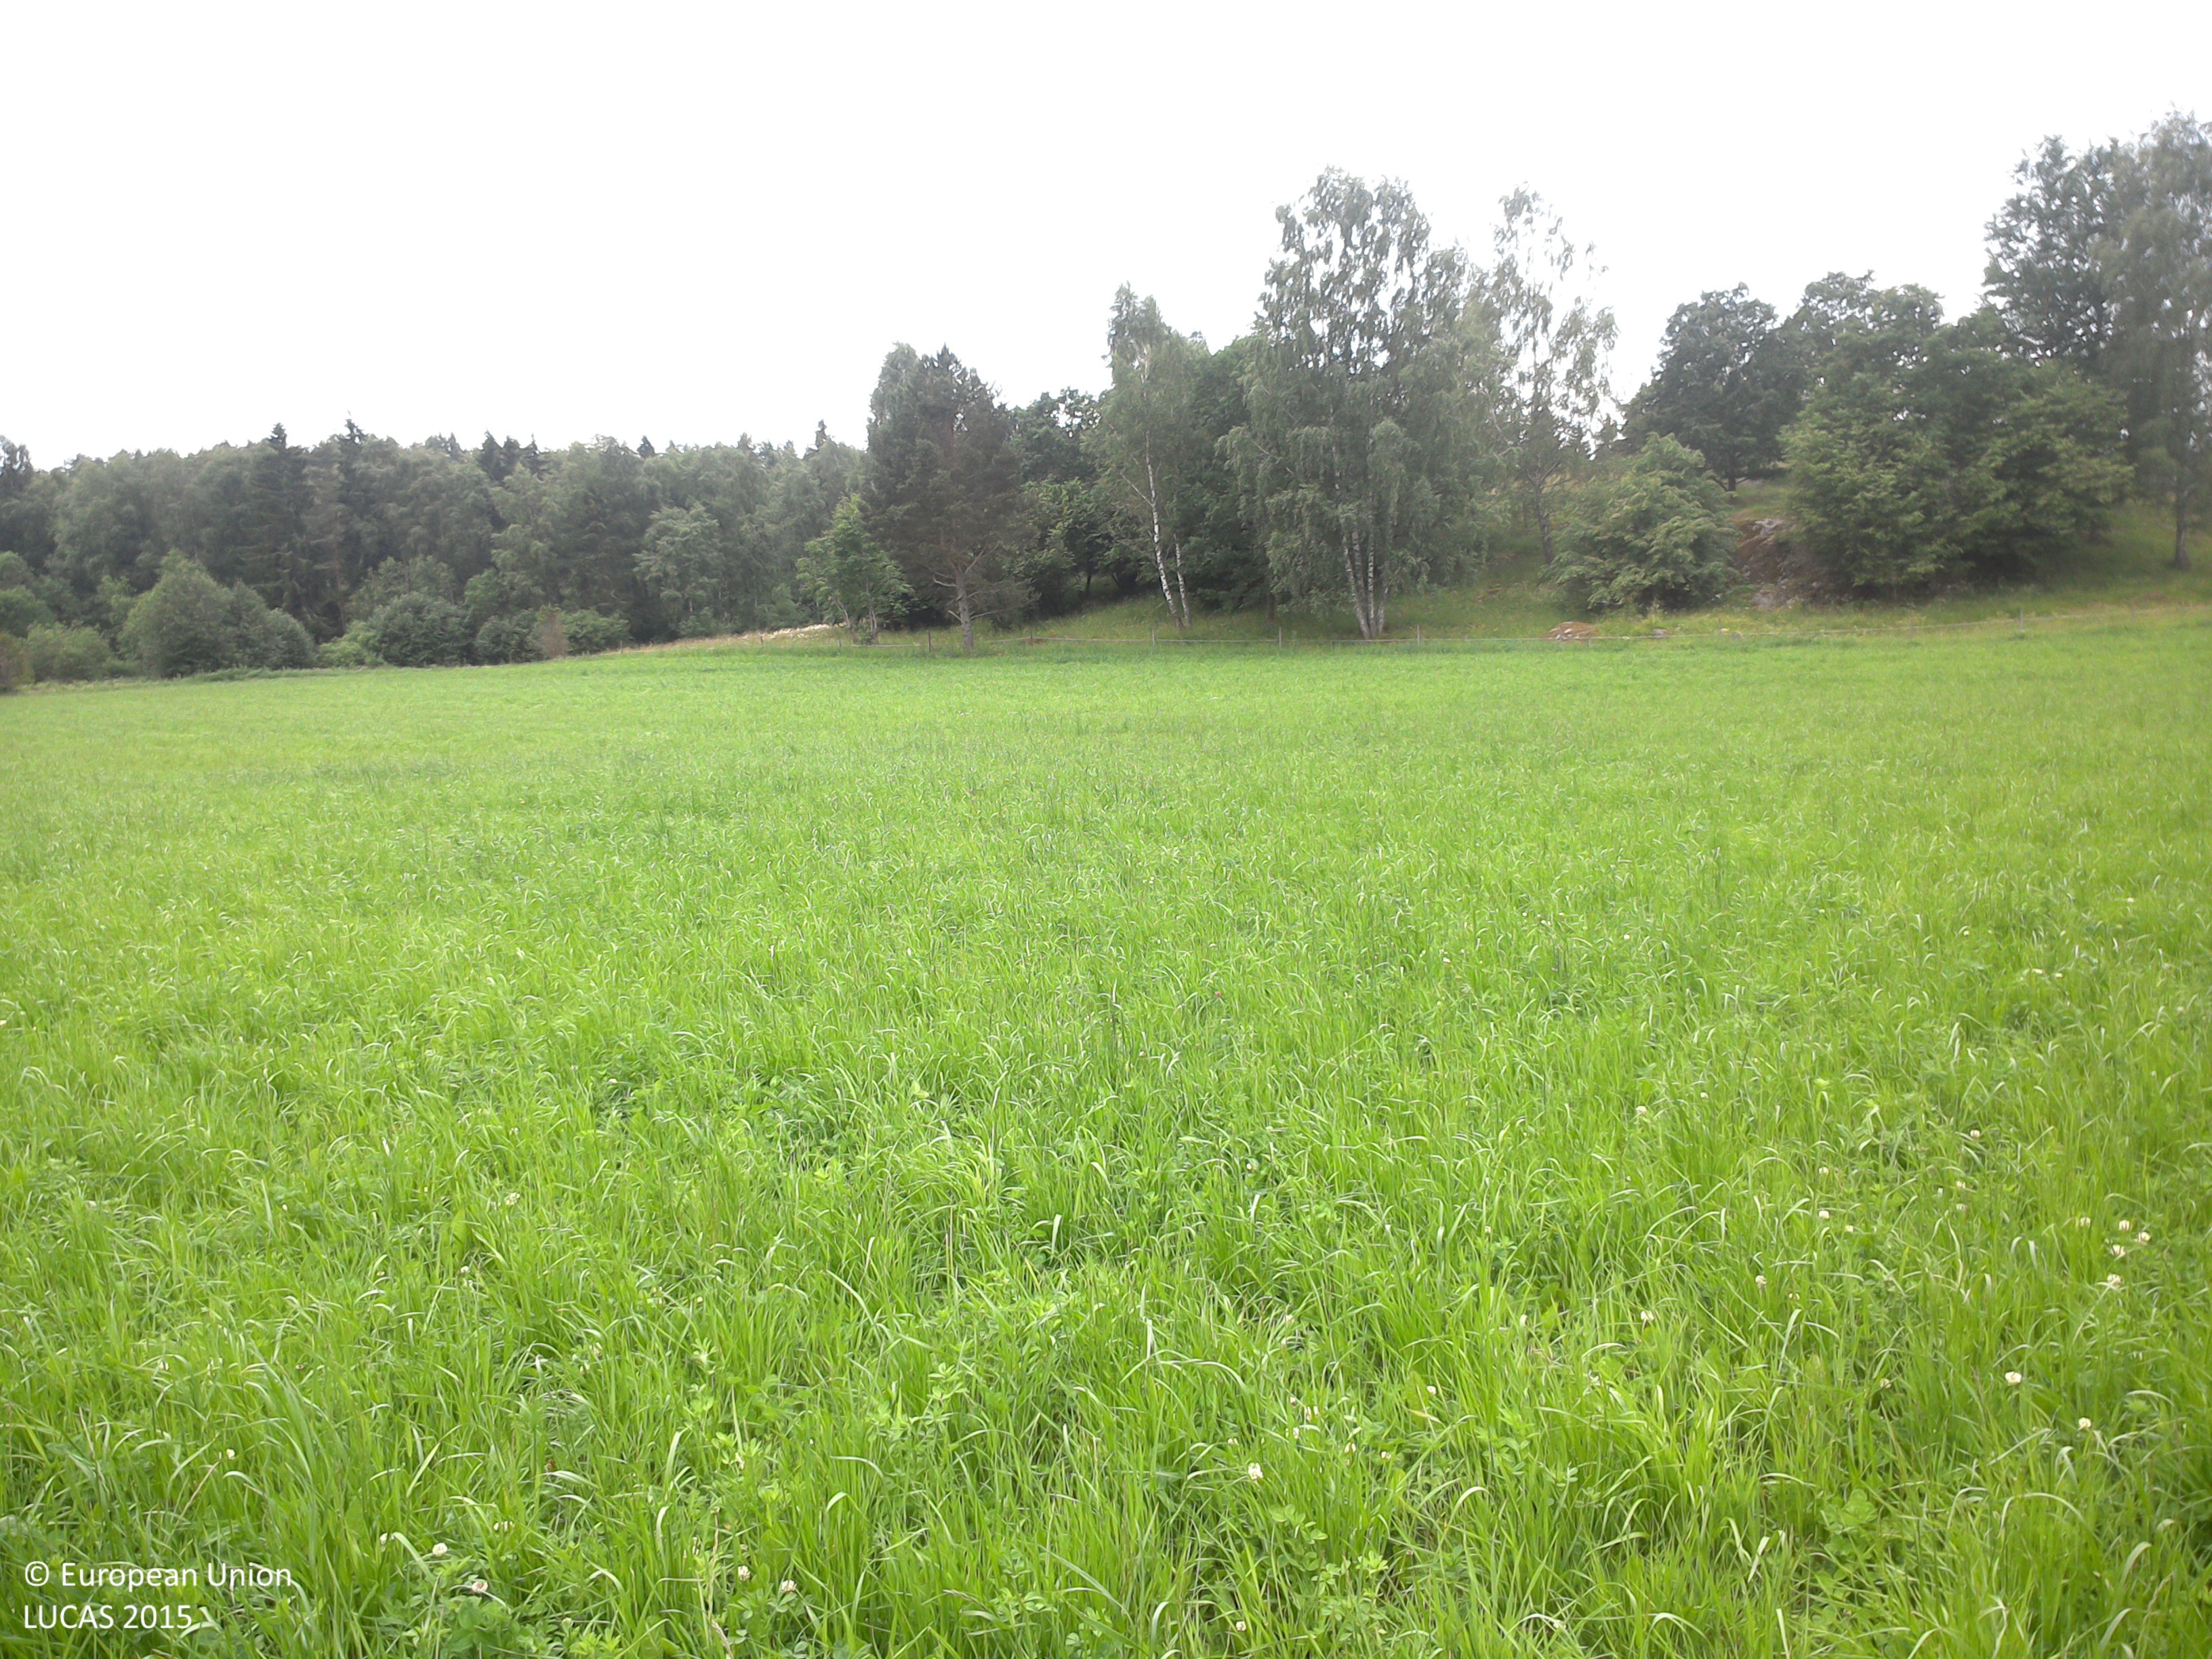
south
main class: Cropland
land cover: Other leguminous and mixtures for fodder
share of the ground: > 75 %
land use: Agriculture (excluding fallow land and kitchen gardens)
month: June
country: SE
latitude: 58.2693
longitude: 15.5011
